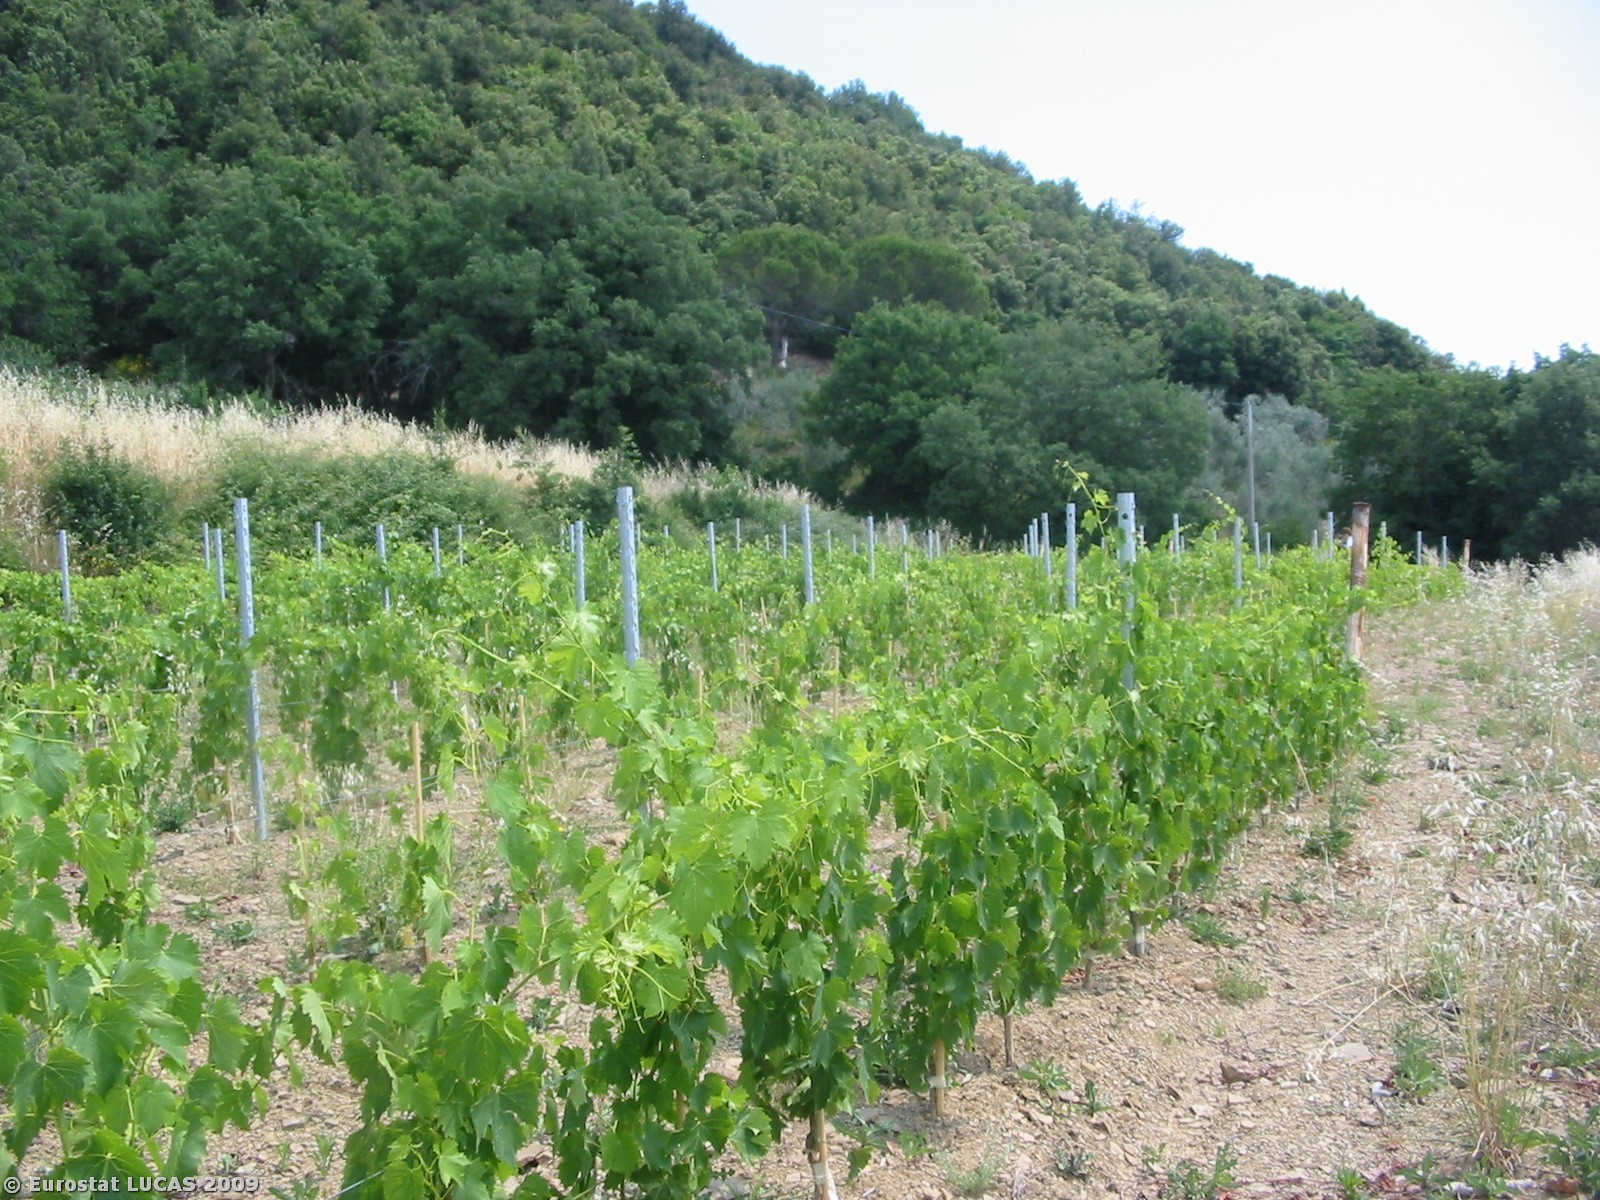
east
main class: Cropland
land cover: Vineyards
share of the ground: 25 - 50 %
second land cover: Grassland with sparse tree/shrub cover
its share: > 75 %
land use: Agriculture (excluding fallow land and kitchen gardens)
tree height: < 5 m
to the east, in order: Vineyards; Grassland with sparse tree/shrub cover; Spontaneously vegetated surfaces; Grass margins; Ditches and canals; Paved roads, cycling and walking lanes; Grass margins; Abandoned hedges; Electric lines; Fences; Olive groves; Grassland with sparse tree/shrub cover; Broadleaved woodland
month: June
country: IT
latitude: 43.3580
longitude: 11.9317
